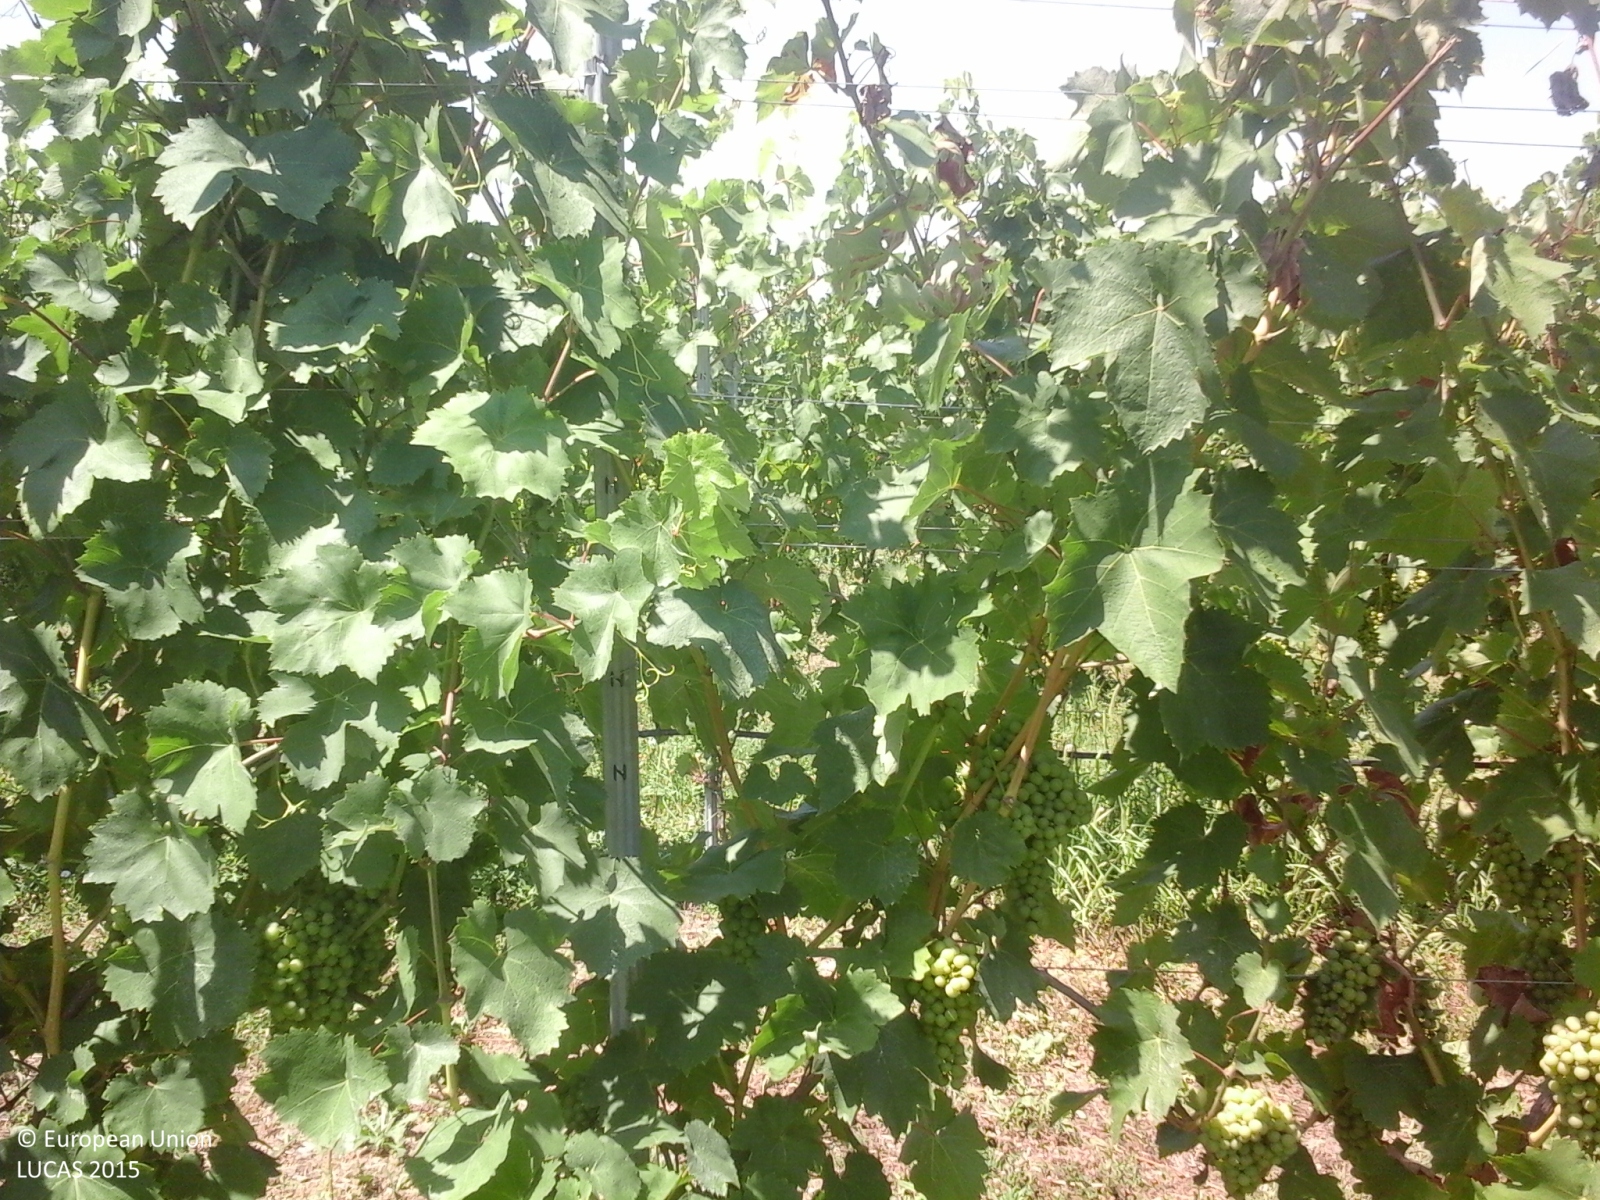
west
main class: Cropland
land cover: Vineyards
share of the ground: 25 - 50 %
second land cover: Grassland without tree/shrub cover
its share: > 75 %
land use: Agriculture (excluding fallow land and kitchen gardens)
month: July
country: IT
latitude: 45.4485
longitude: 10.6254
